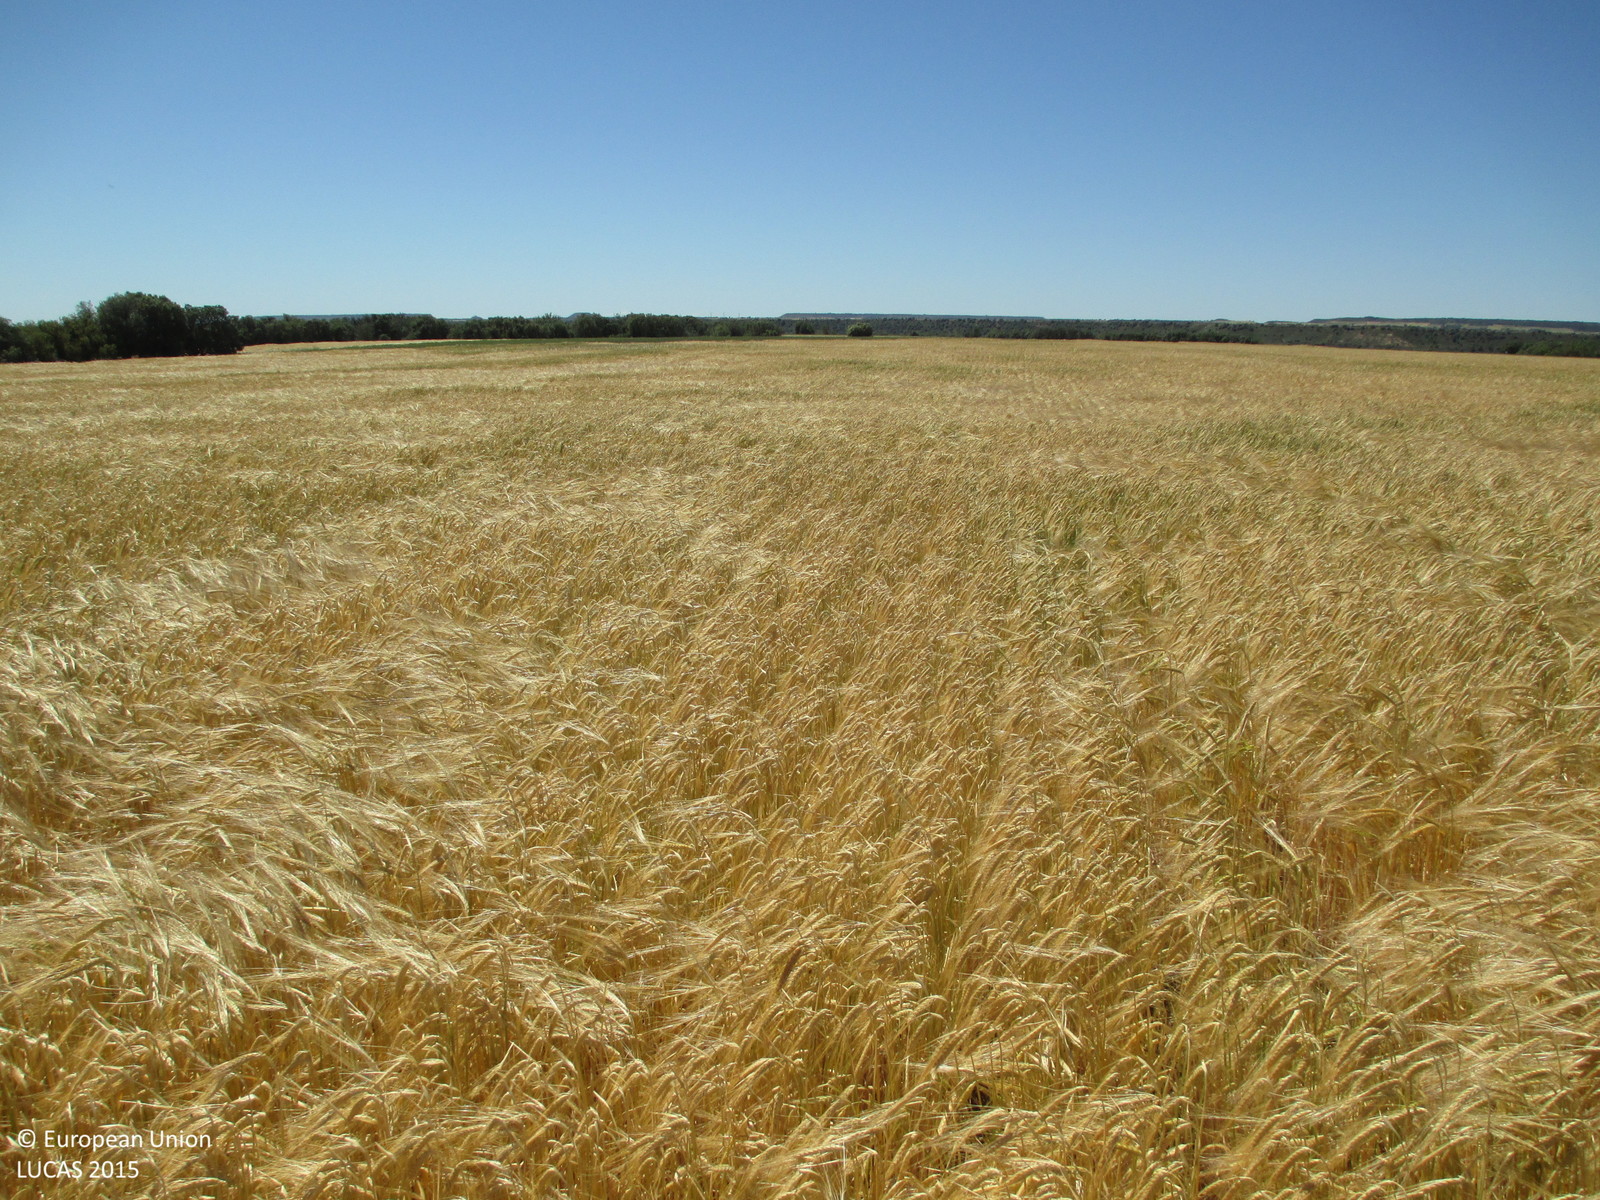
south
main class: Cropland
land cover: Barley
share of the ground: > 75 %
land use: Agriculture (excluding fallow land and kitchen gardens)
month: May
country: ES
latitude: 42.0235
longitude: -0.2499
